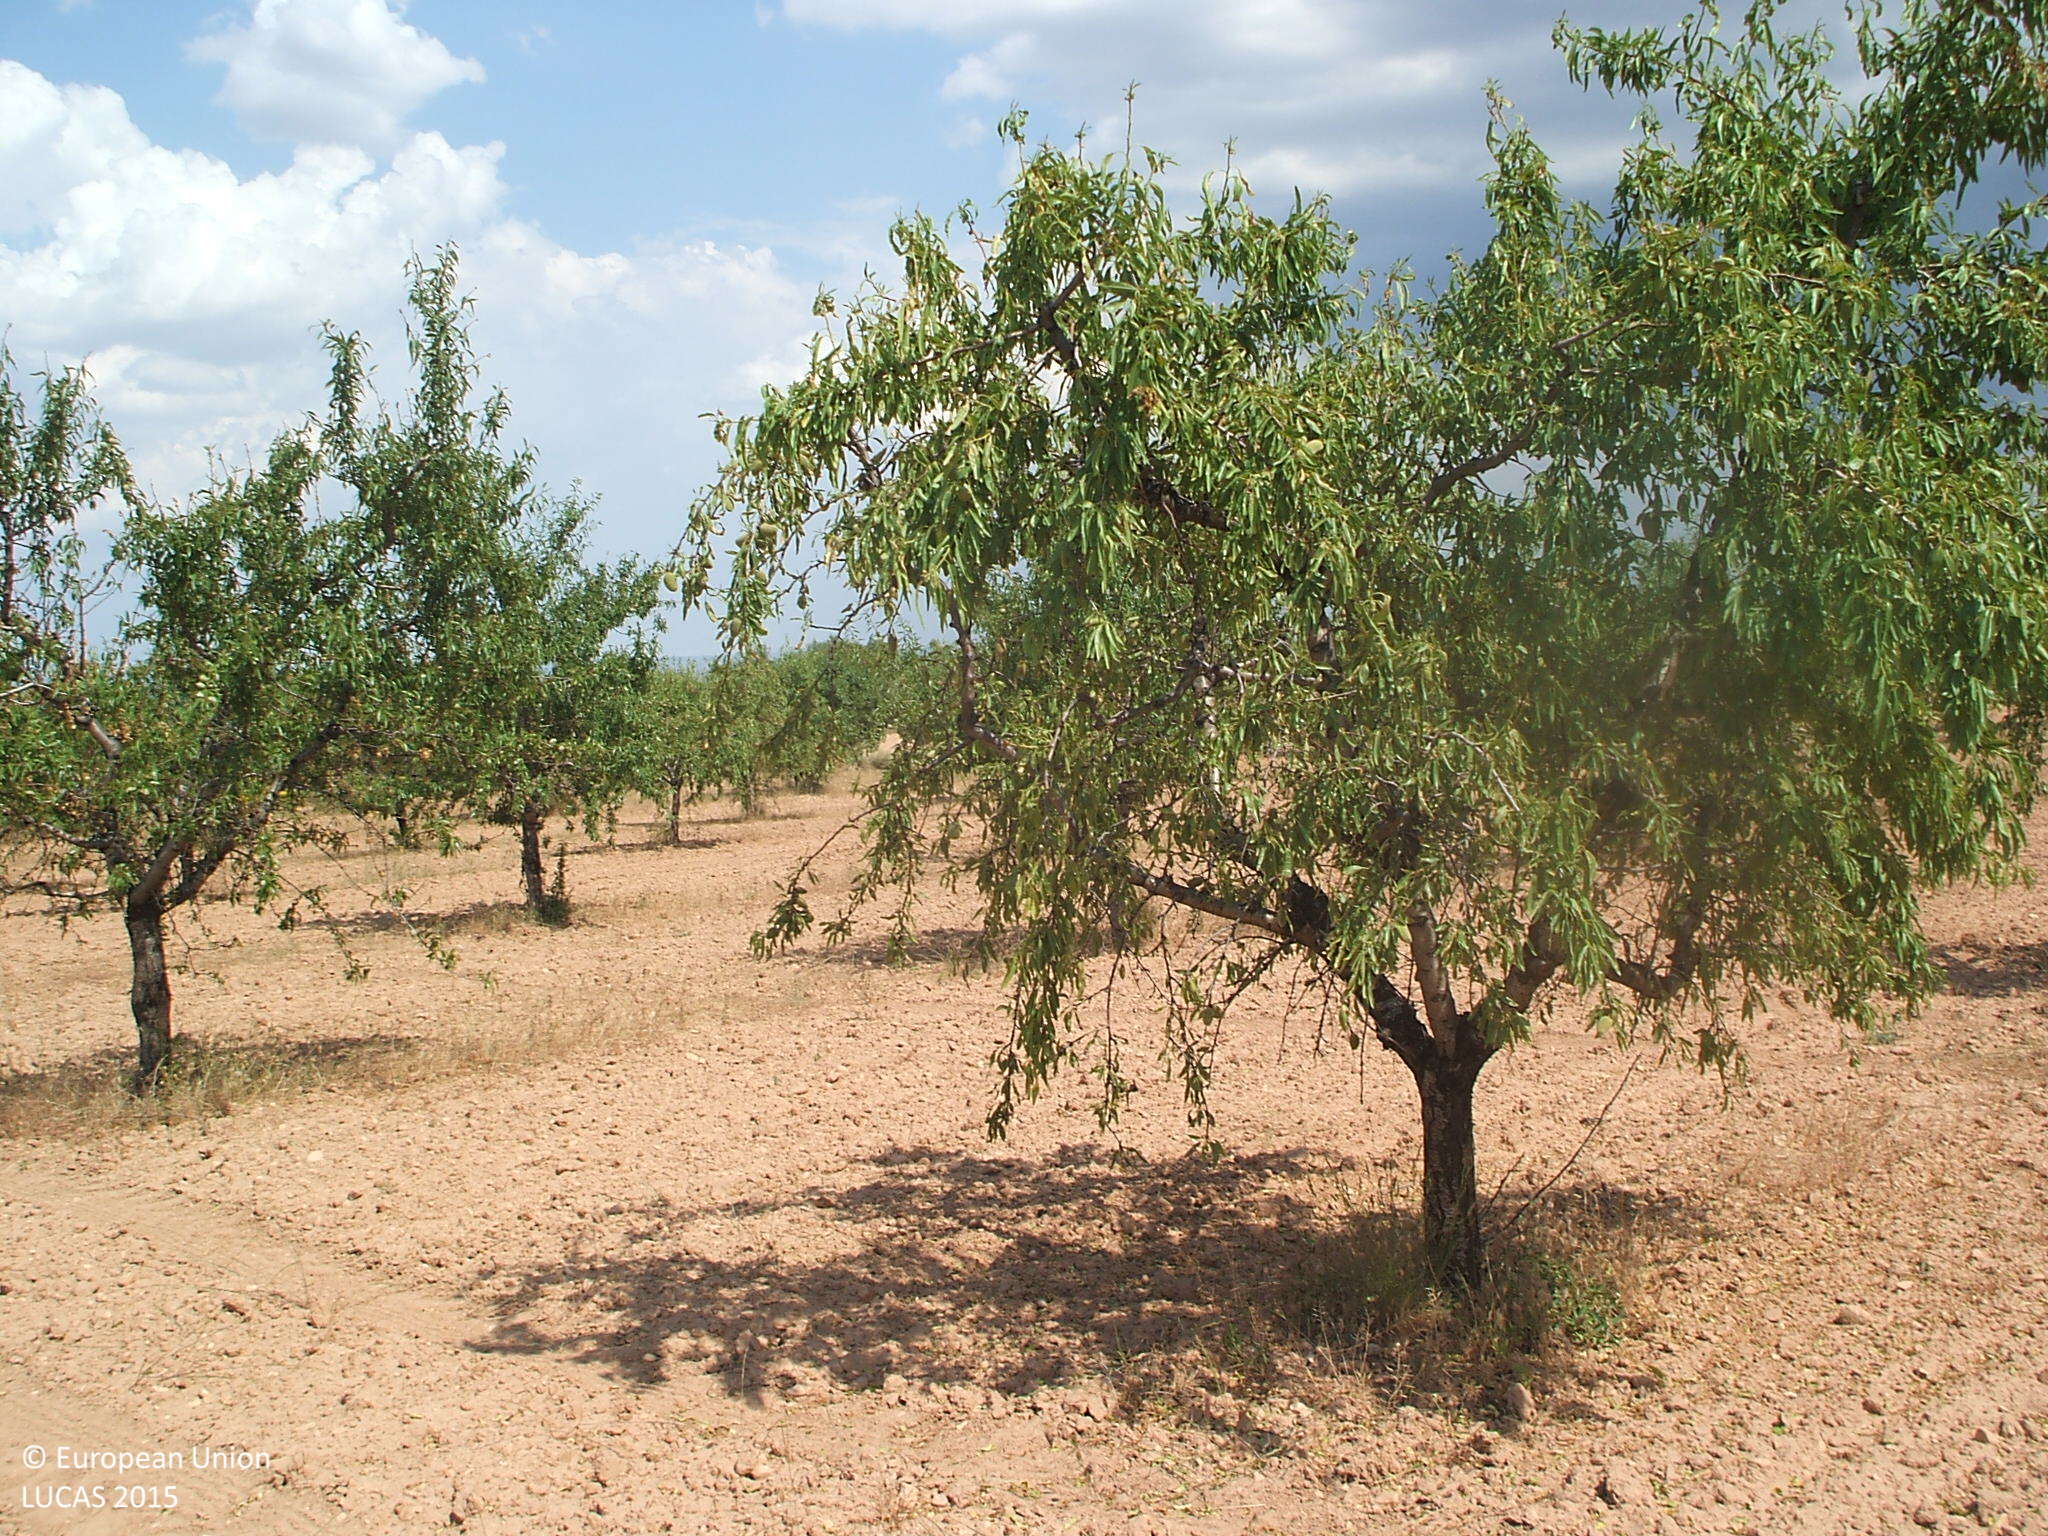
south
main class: Cropland
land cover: Nuts trees
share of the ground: 25 - 50 %
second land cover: Other bare soil
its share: > 75 %
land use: Agriculture (excluding fallow land and kitchen gardens)
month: June
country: ES
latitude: 40.9662
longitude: -0.2659
